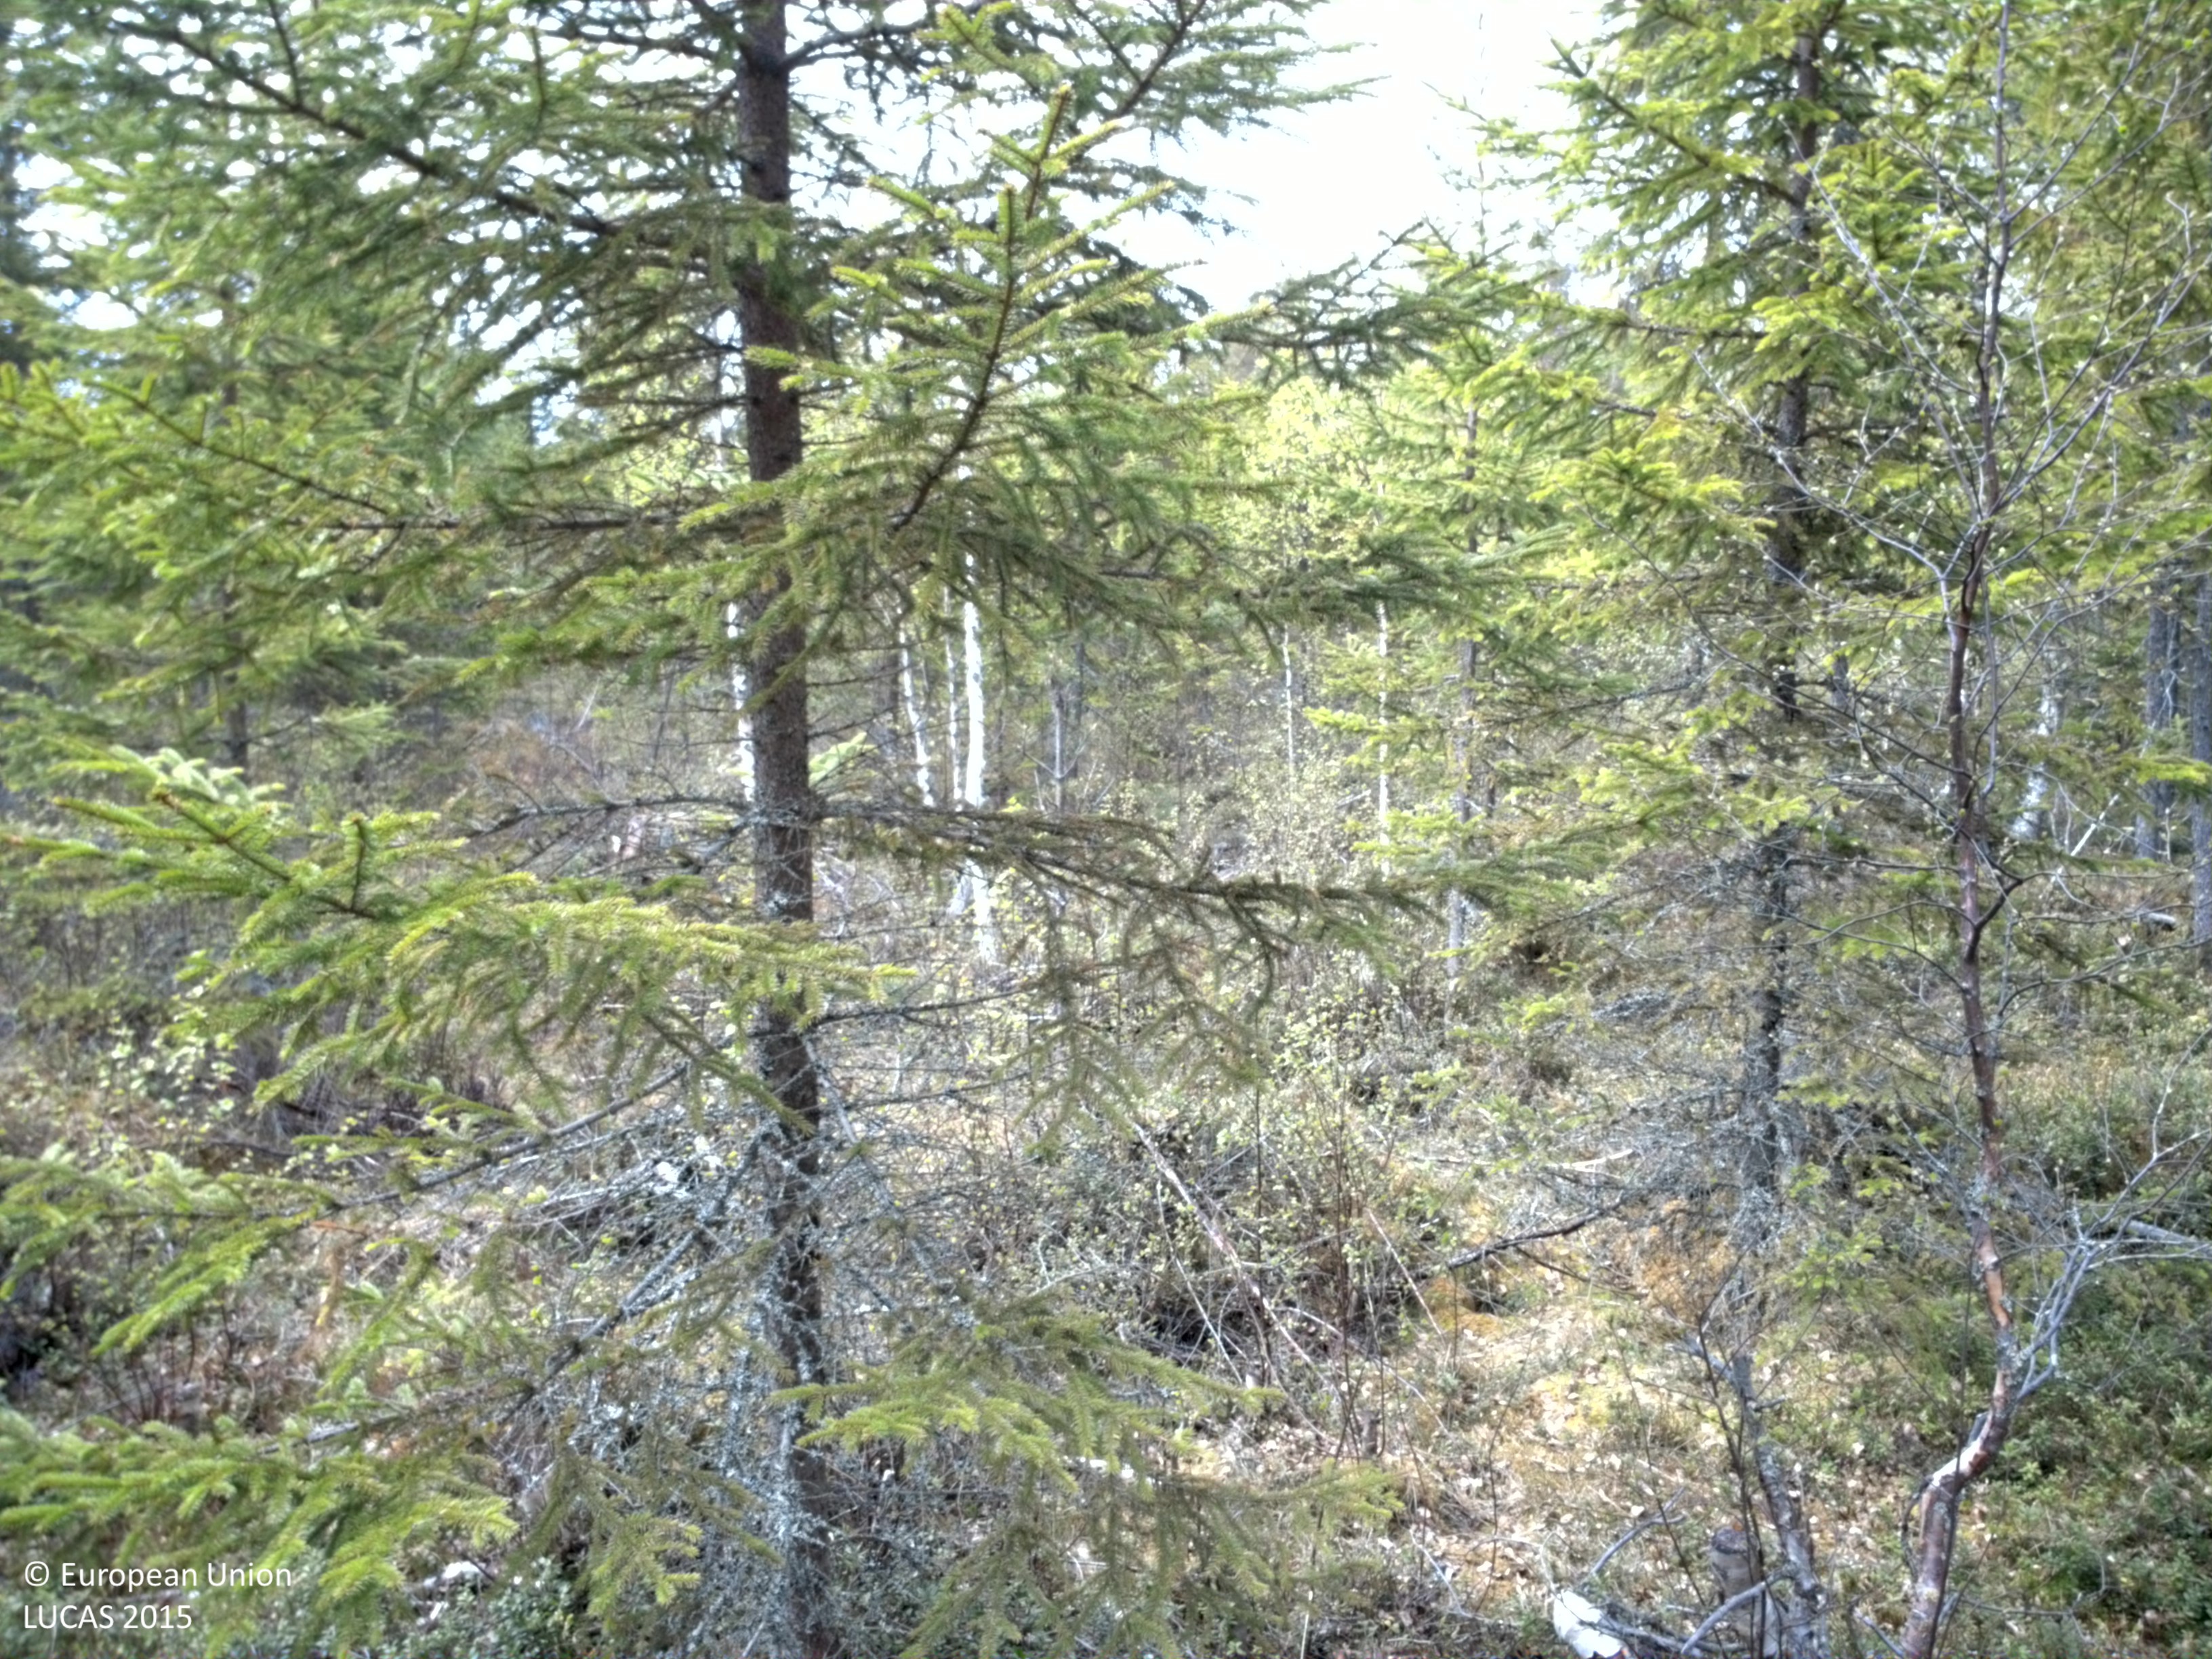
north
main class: Woodland
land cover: Spruce dominated mixed woodland
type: boreal forest
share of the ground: 50 - 75 %
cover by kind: shrubs 35 %, coniferous forest trees 30 %, broadleaved forest trees 25 %, lichens and mosses 10 %
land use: Forestry
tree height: > 5 m
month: May
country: SE
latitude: 61.1207
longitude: 15.4981
